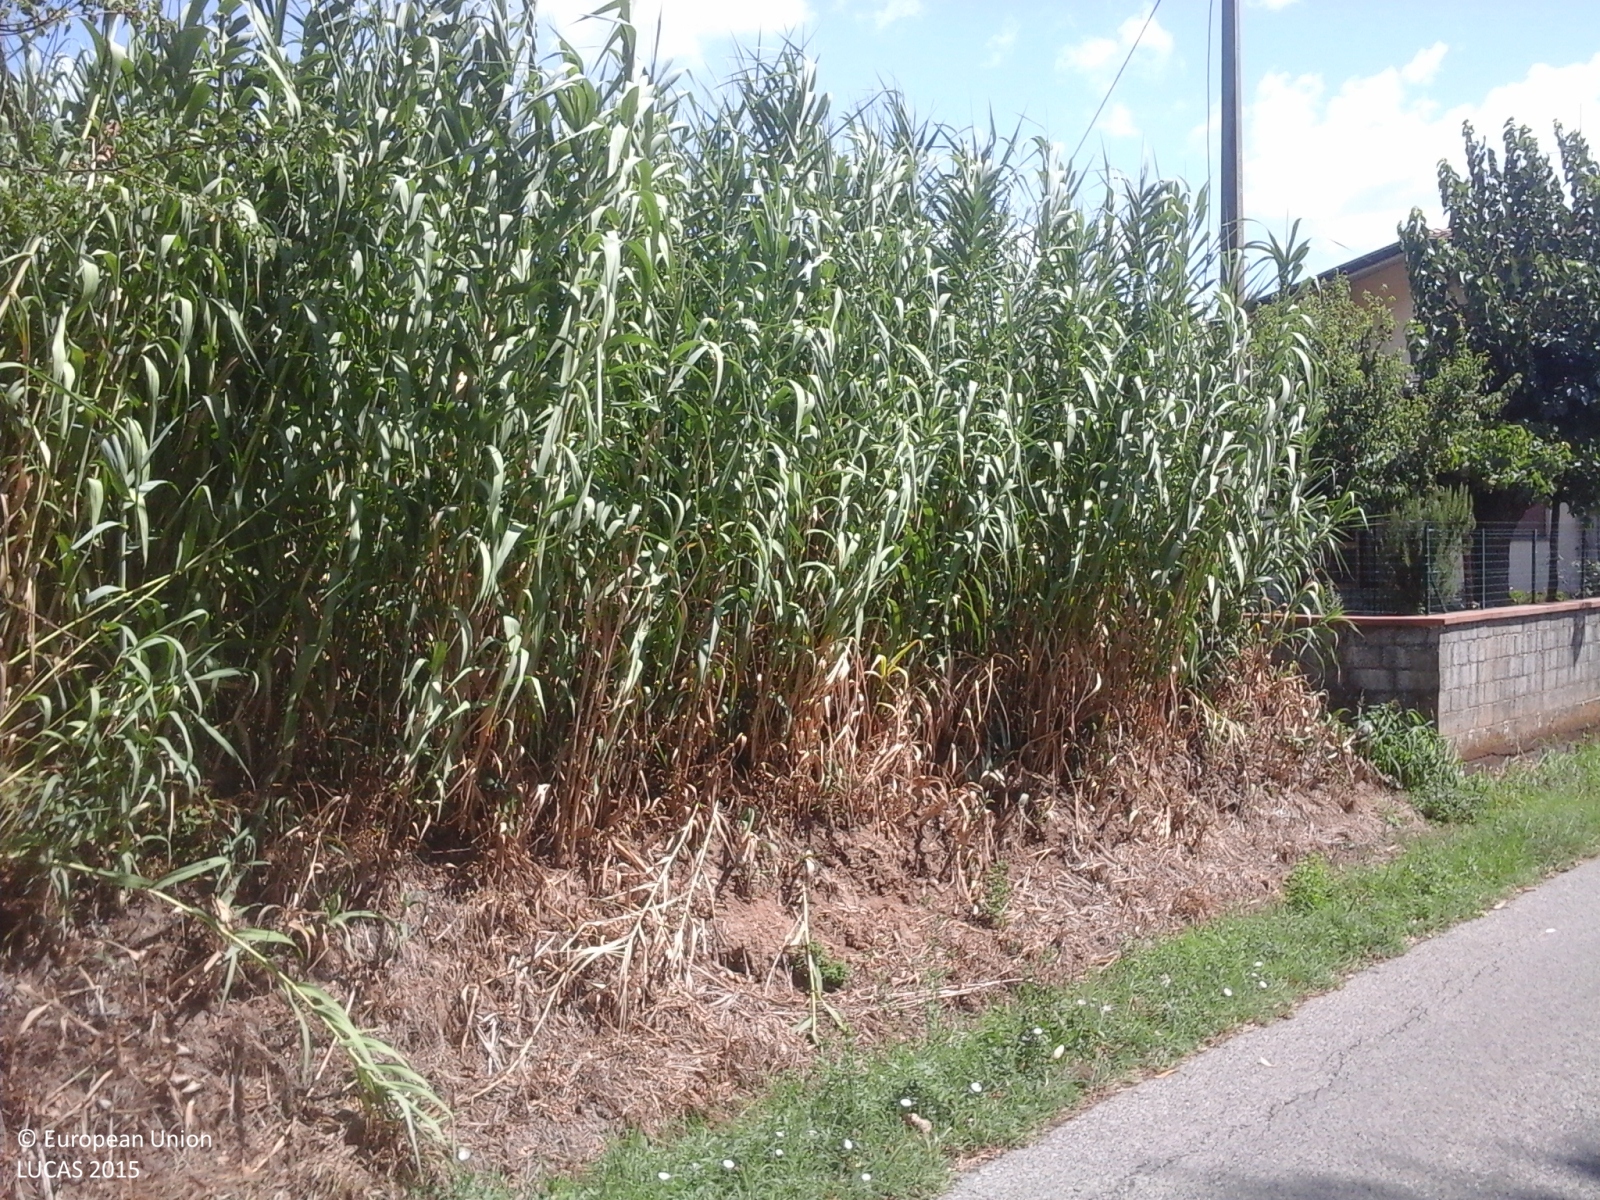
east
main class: Grassland
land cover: Grassland without tree/shrub cover
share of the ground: > 75 %
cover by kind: herbaceous plants 100 %
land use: Residential
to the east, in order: Managed hedges; Fences; Grassland without tree/shrub cover; Fences; Managed hedges; Grass margins; Ditches and canals; Grass margins; Paved roads, cycling and walking lanes; Grass margins; Shrubland without tree cover; Artificial constructions in urban areas; Grassland without tree/shrub cover; Ditches and canals; Grassland without tree/shrub cover; Abandoned hedges; Grassland without tree/shrub cover; Abandoned hedges; Grassland without tree/shrub cover; Ditches and canals; Grass margins; Artificial constructions in urban areas
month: August
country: IT
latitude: 43.8605
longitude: 10.7818
